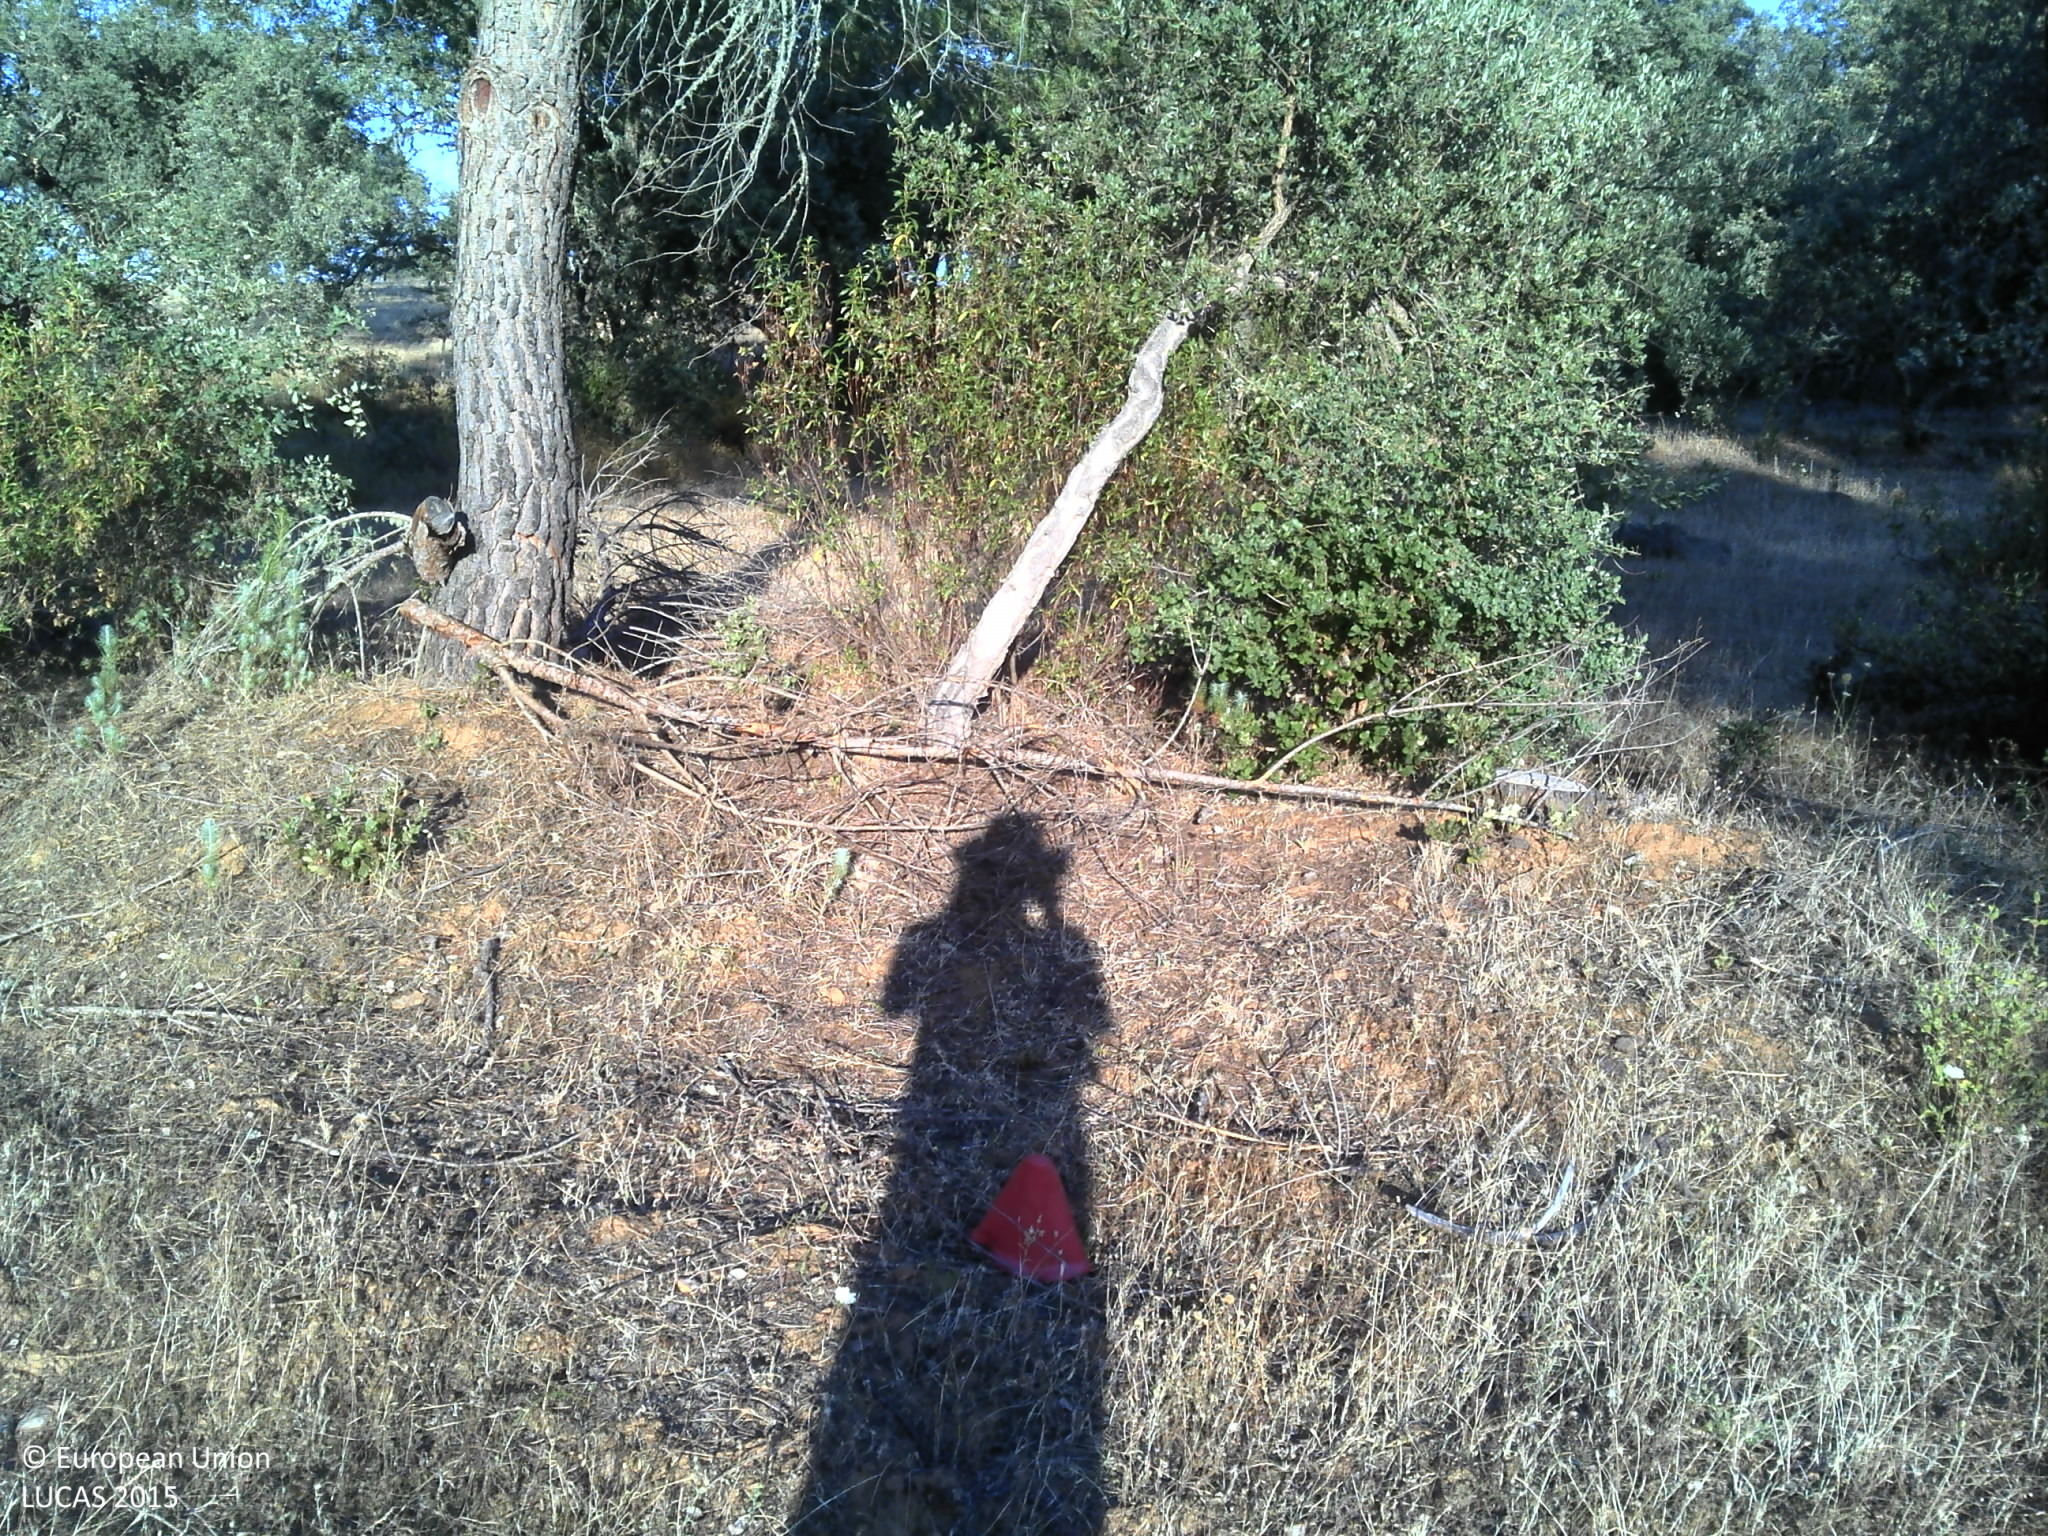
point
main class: Woodland
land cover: Other mixed woodland
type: broadleaved evergreen forest
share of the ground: 50 - 75 %
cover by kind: broadleaved forest trees 50 %, coniferous forest trees 35 %, herbaceous plants 15 %
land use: Forestry
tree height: > 5 m
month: June
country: PT
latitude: 38.0722
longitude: -7.1924
